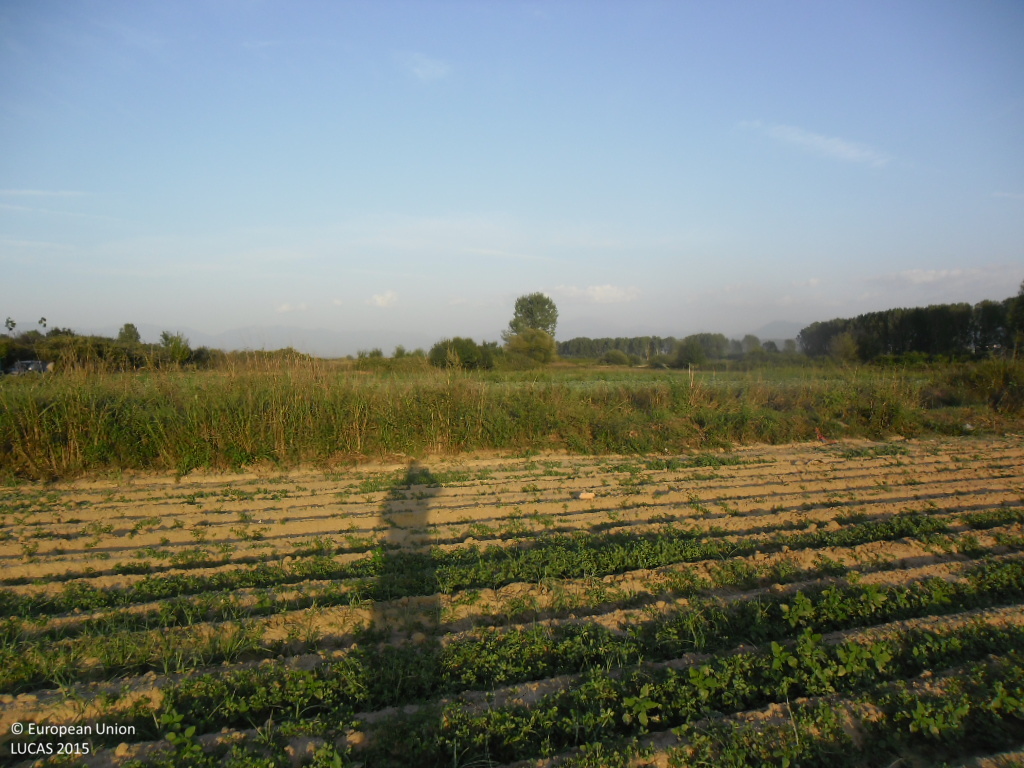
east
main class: Cropland
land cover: Potatoes
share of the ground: < 10 %
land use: Agriculture (excluding fallow land and kitchen gardens)
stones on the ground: < 10 %
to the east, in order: Potatoes; Grass margins; Ditches and canals; Grass margins; Other fresh vegetables; Spontaneously vegetated surfaces; Tracks; Broadleaved woodland; Grassland without tree/shrub cover; Other fresh vegetables
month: September
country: BG
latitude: 41.4245
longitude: 23.1690
